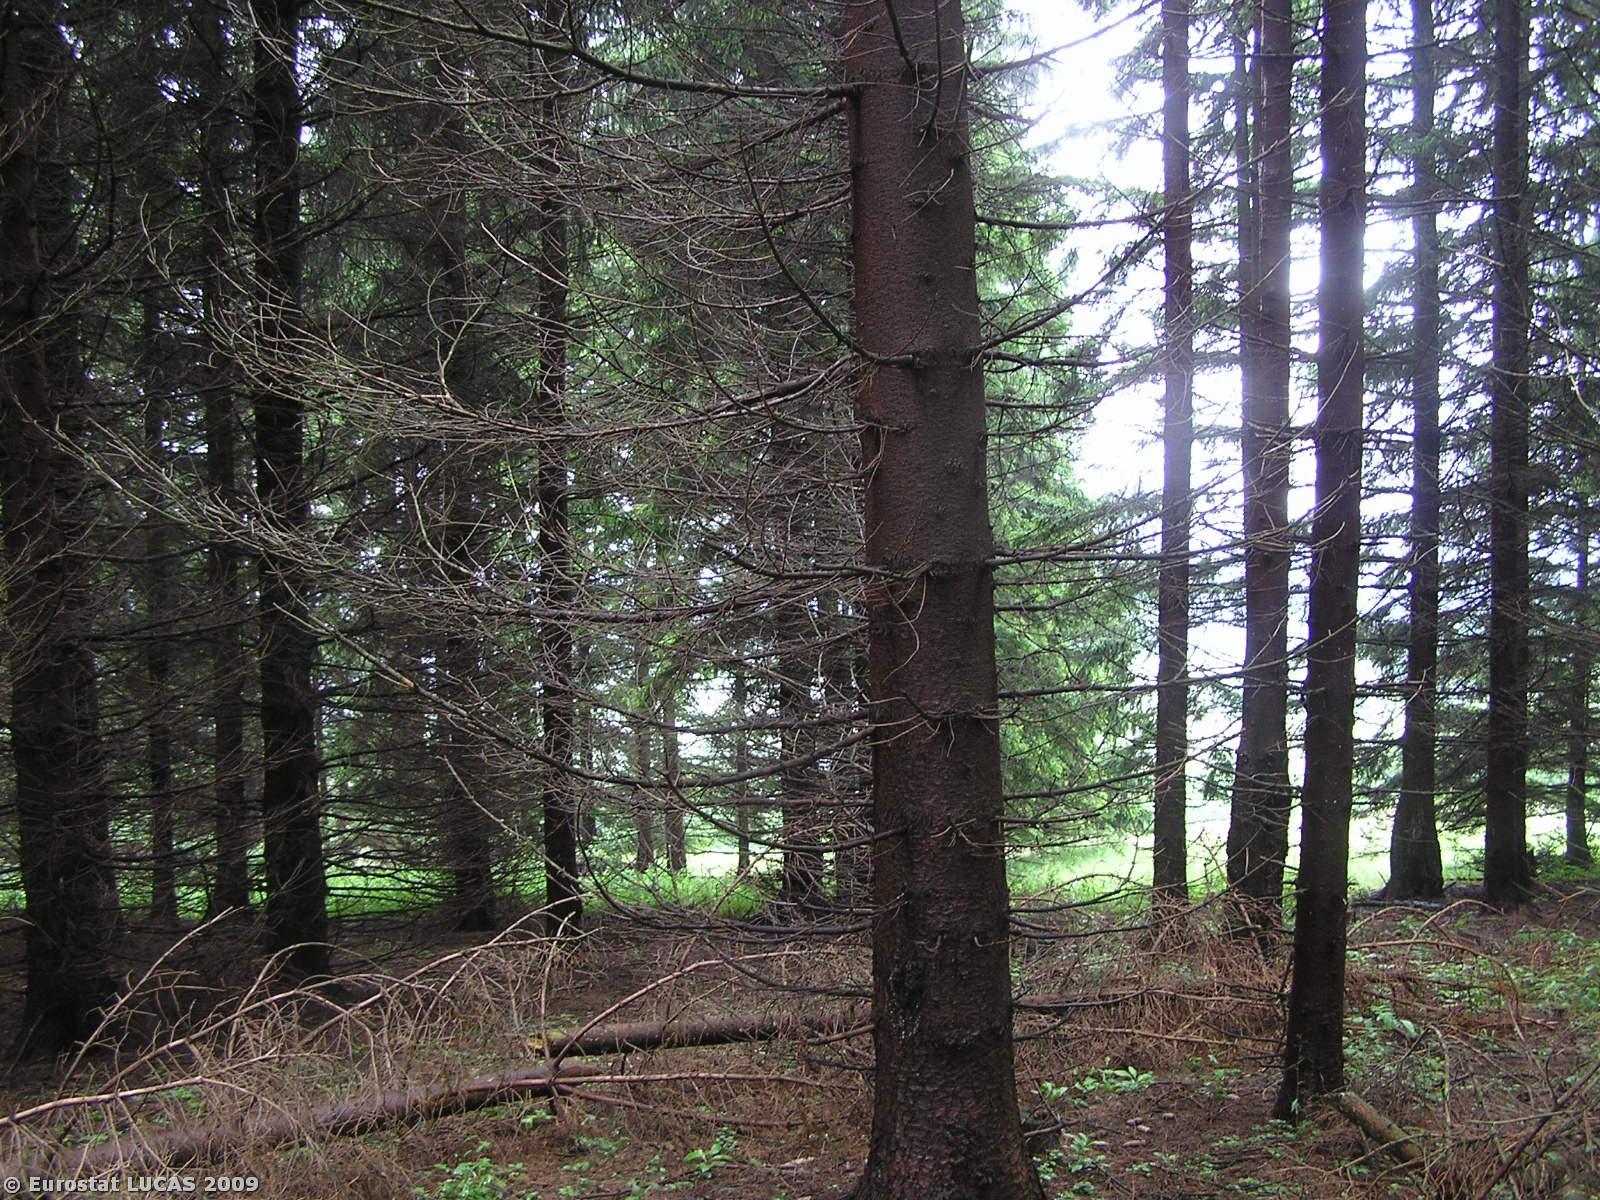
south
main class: Woodland
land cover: Coniferous woodland
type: hemiboreal forest and nemoral coniferous forest and mixed broadleaved-coniferous forest
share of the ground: > 75 %
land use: Forestry
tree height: > 5 m
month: May
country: CZ
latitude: 50.1395
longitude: 17.4418
